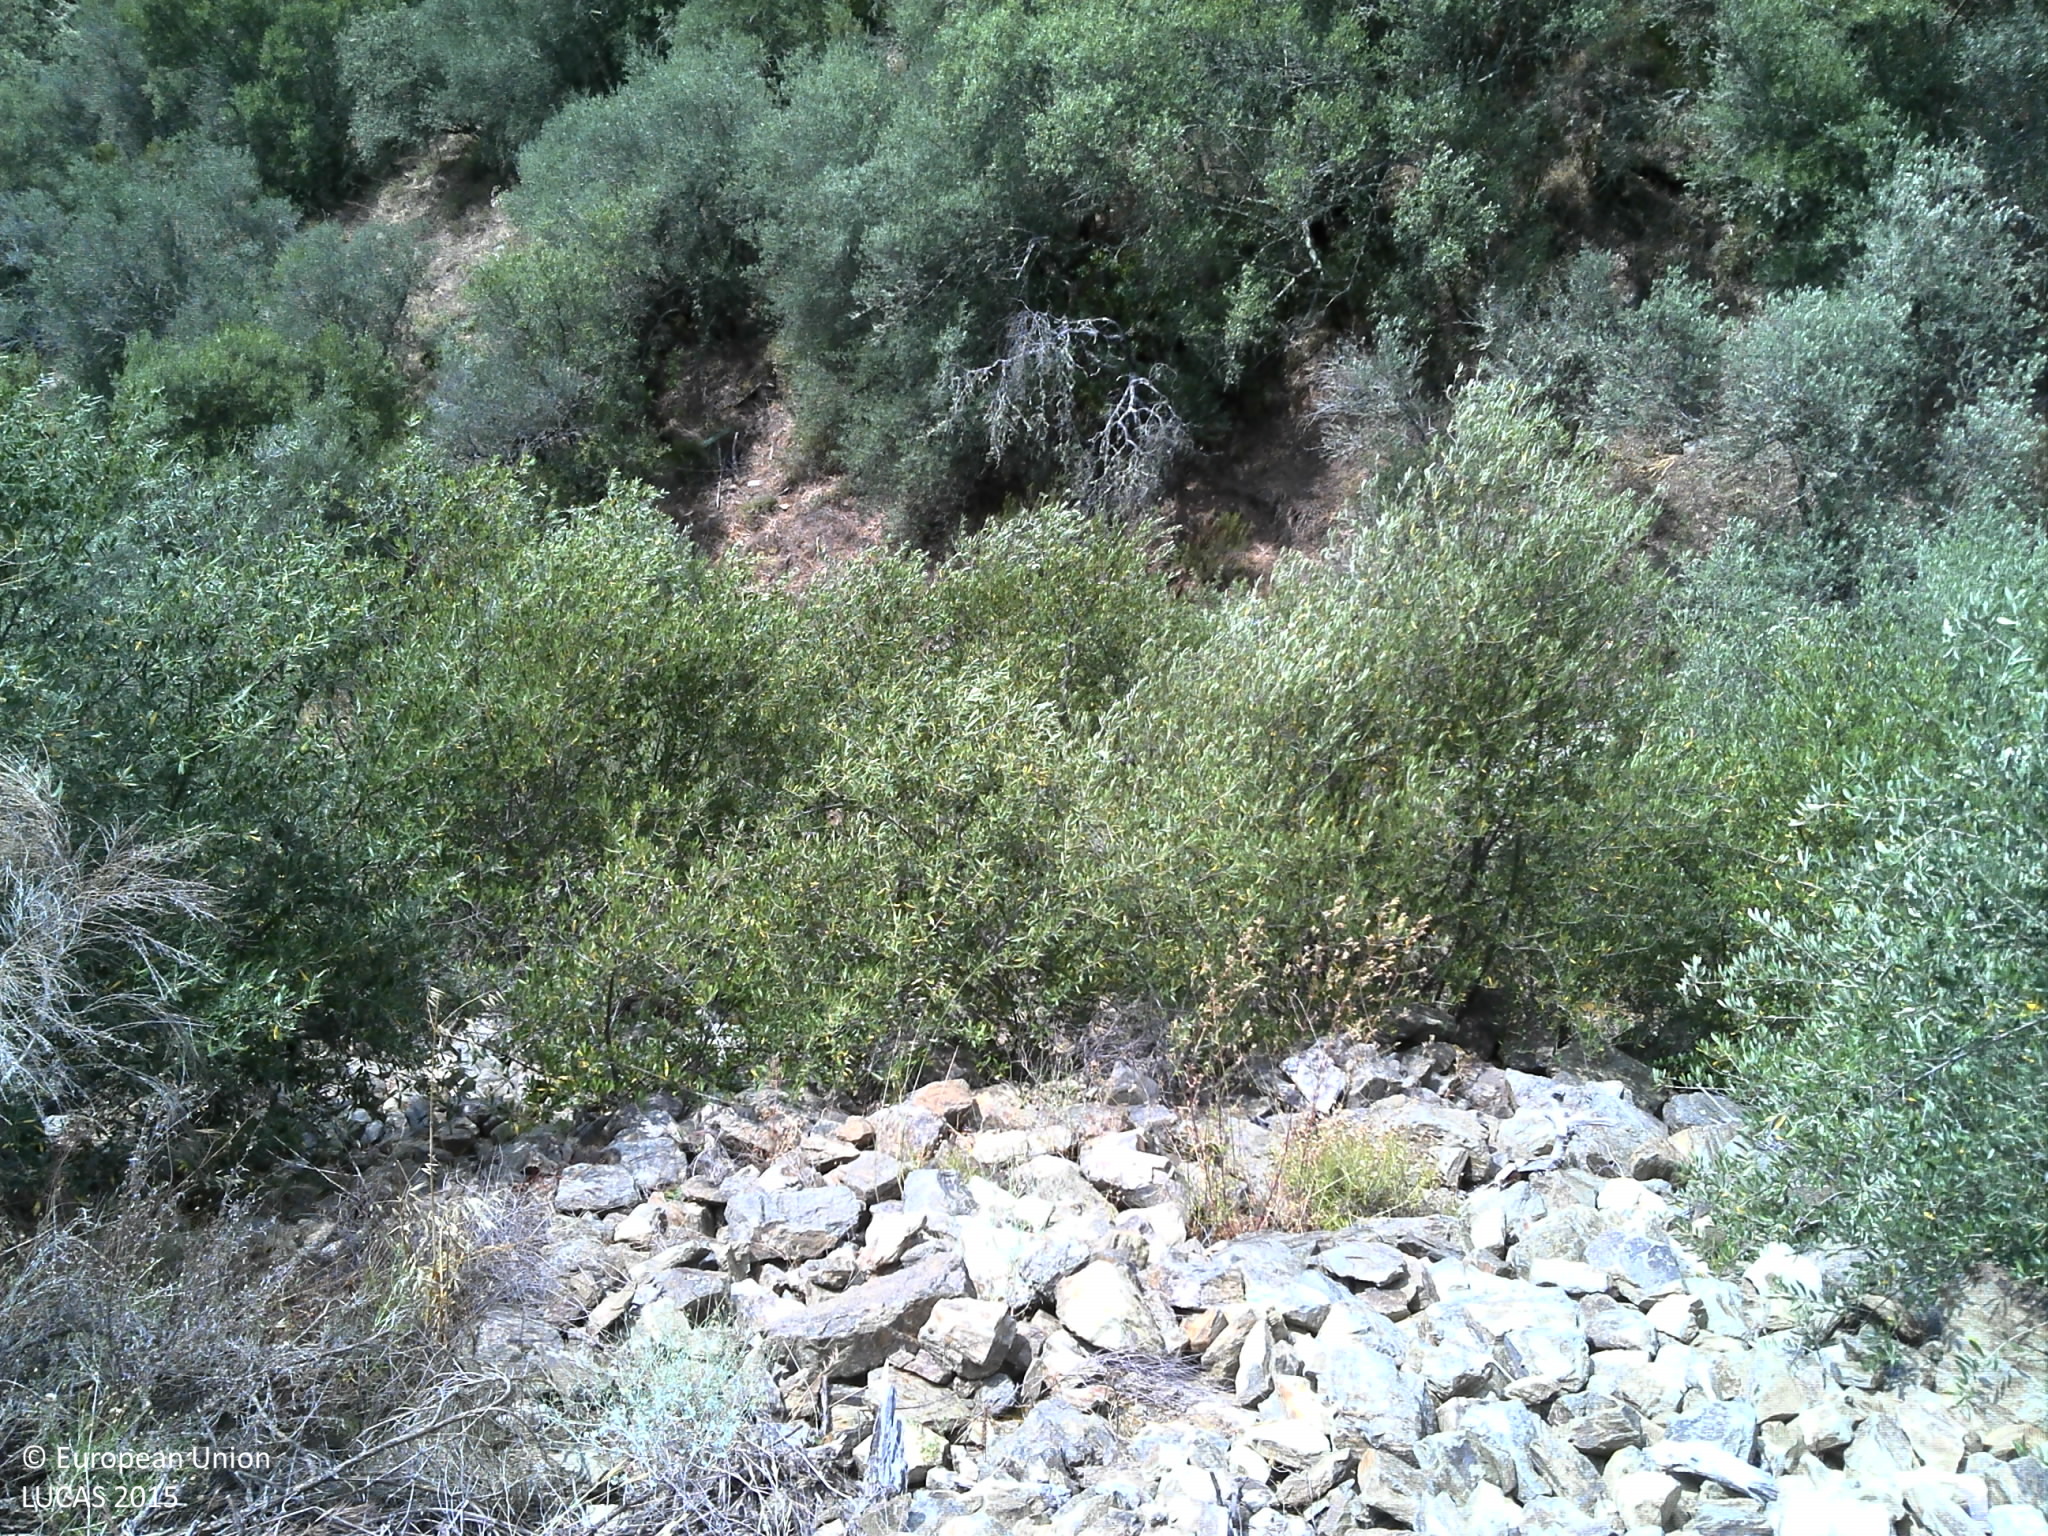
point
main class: Cropland
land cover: Olive groves
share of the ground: < 10 %
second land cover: Shrubland without tree cover
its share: 50 - 75 %
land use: Abandoned areas
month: June
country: PT
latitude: 41.1386
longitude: -7.4789
